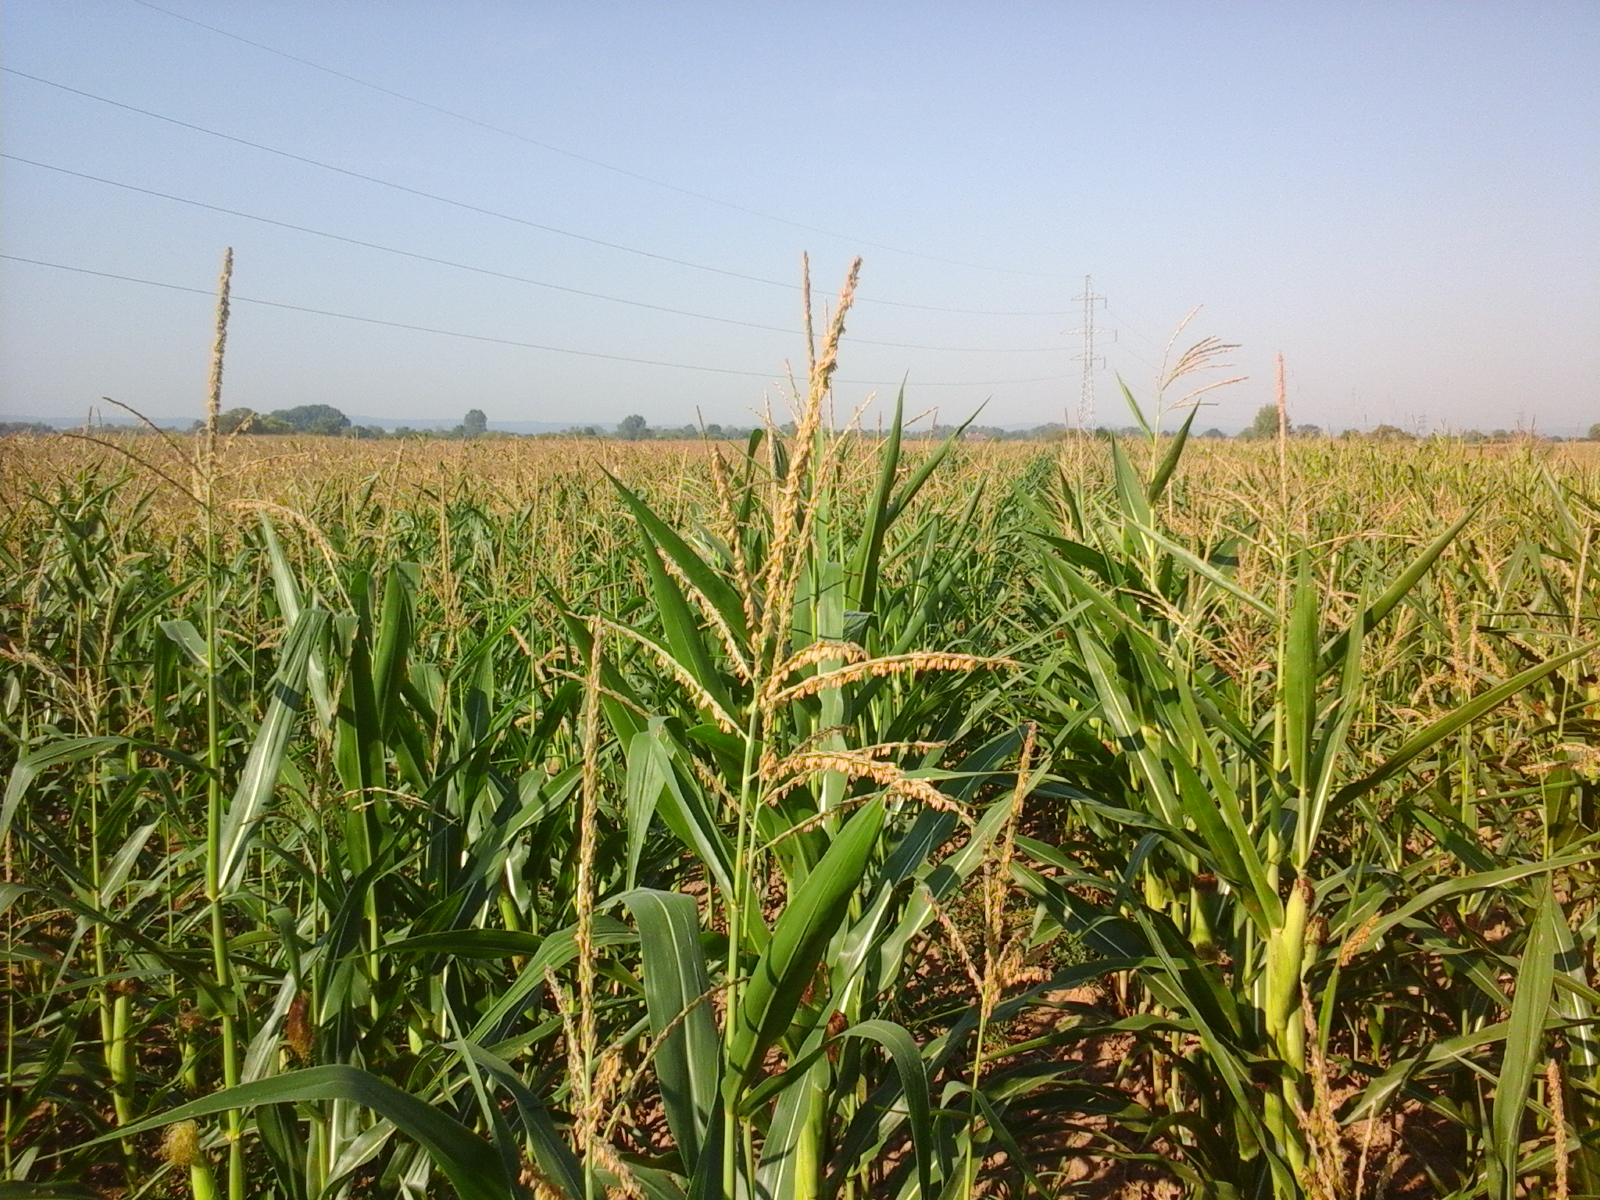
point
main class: Cropland
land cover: Maize
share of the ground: > 75 %
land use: Agriculture (excluding fallow land and kitchen gardens)
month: August
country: RO
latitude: 46.0202
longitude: 22.1470
